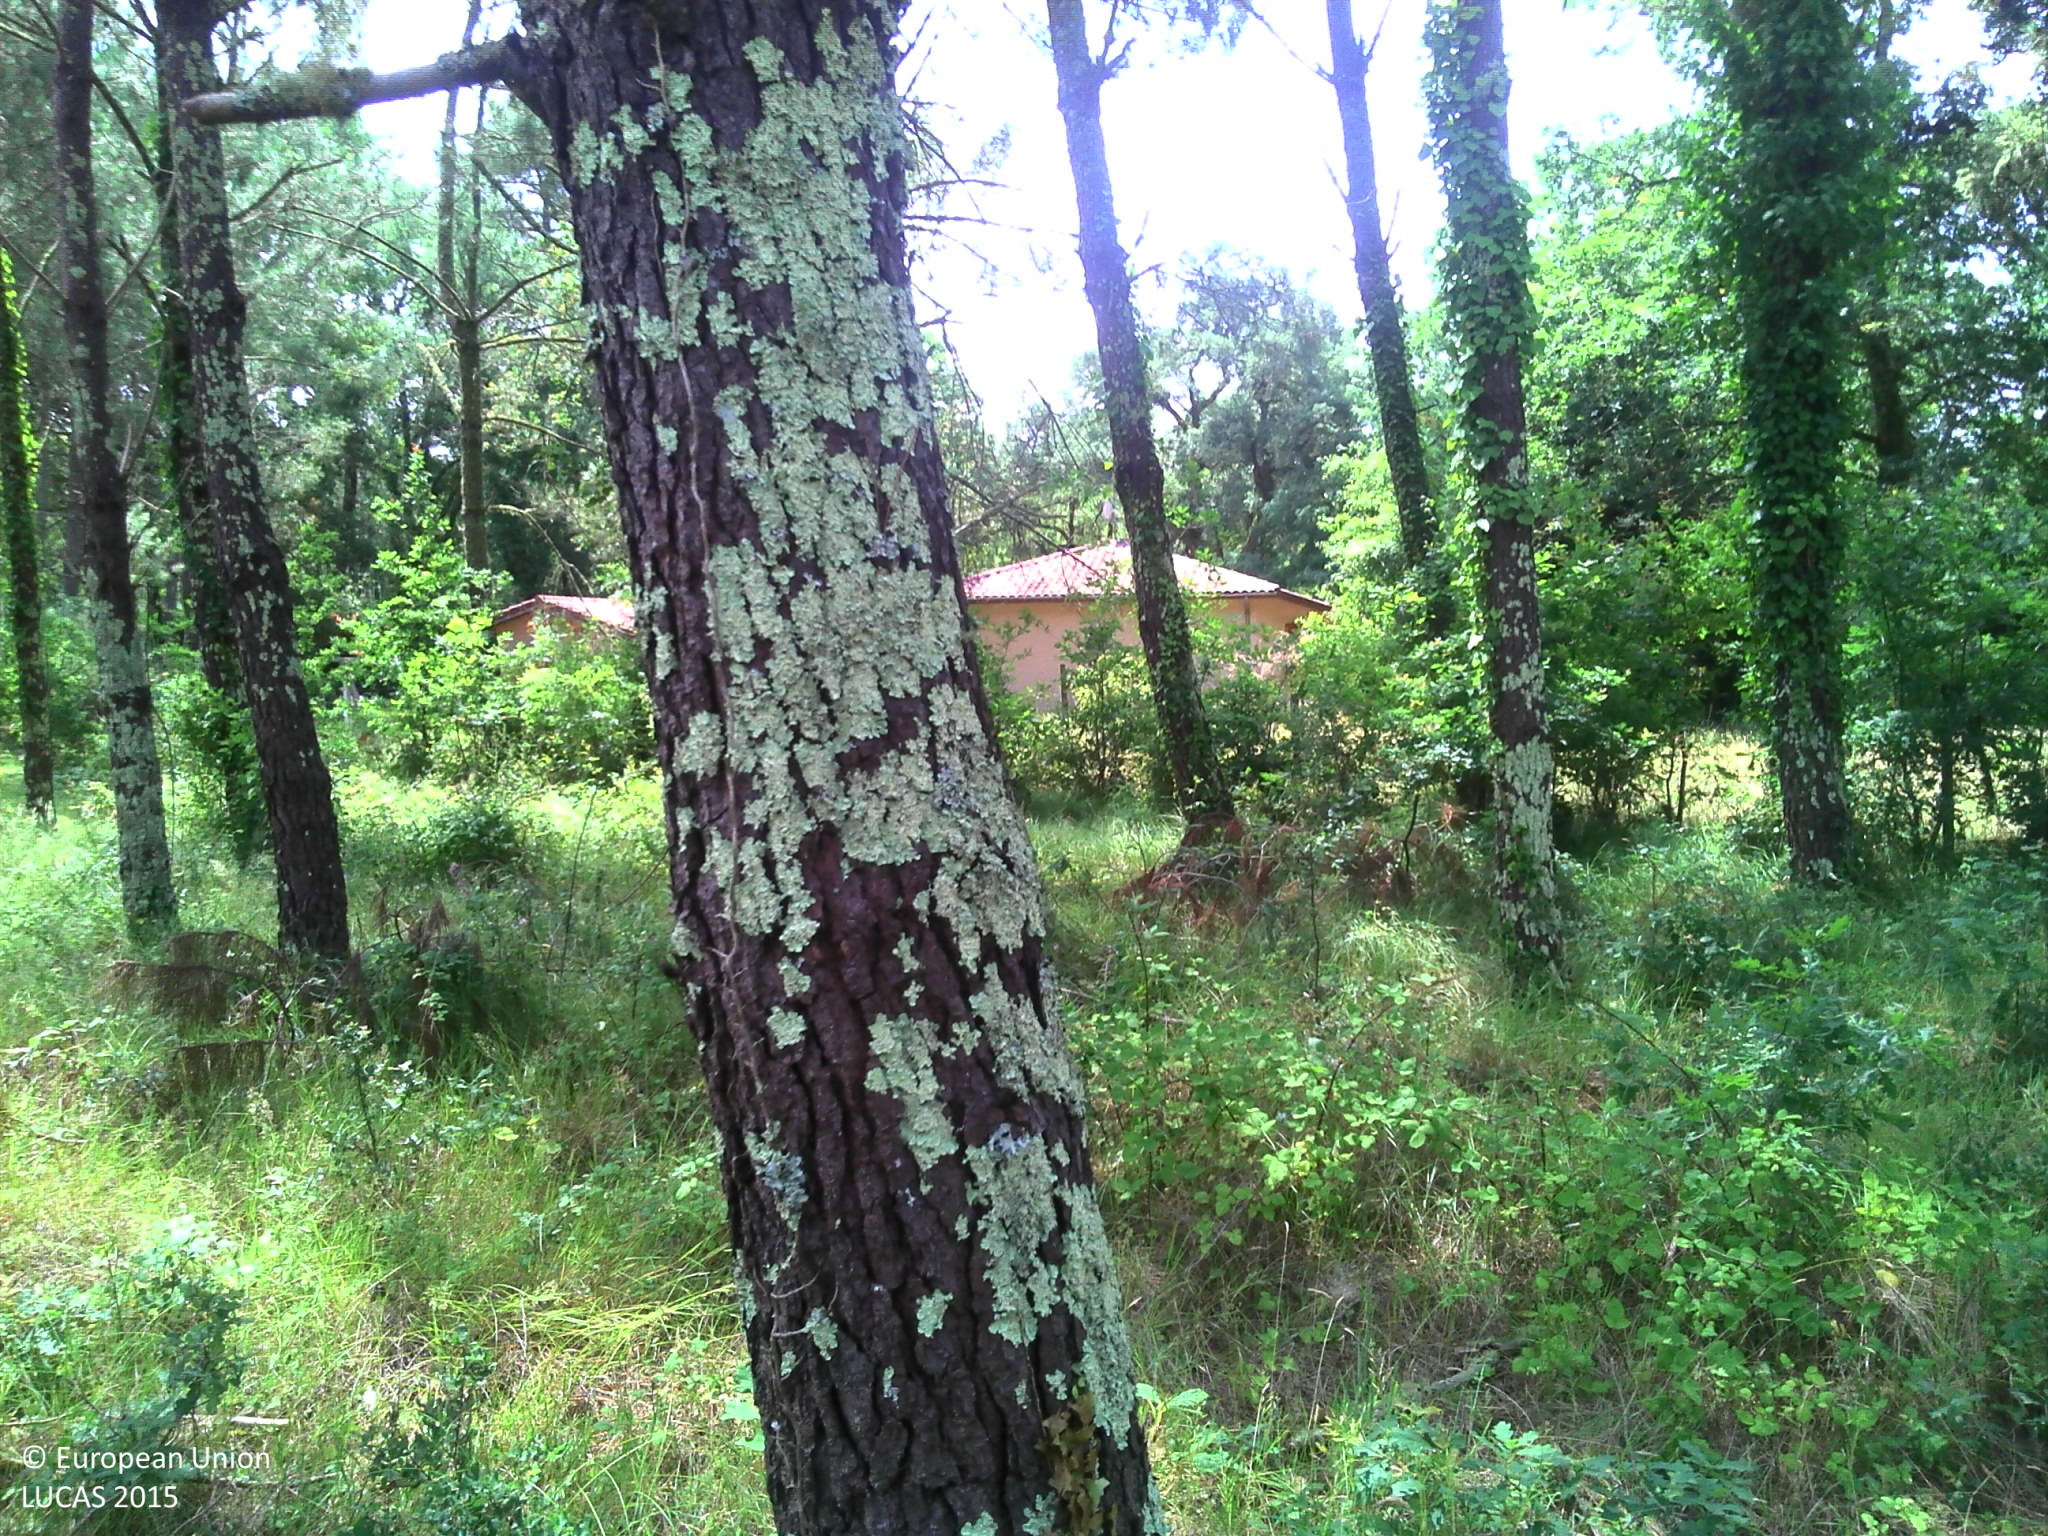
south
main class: Woodland
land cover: Pine dominated coniferous woodland
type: coniferous forest of the mediterranean region
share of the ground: > 75 %
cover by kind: coniferous forest trees 90 %, broadleaved forest trees 5 %, herbaceous plants 5 %
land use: Forestry
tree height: > 5 m
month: July
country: FR
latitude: 43.8048
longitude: -1.2929
